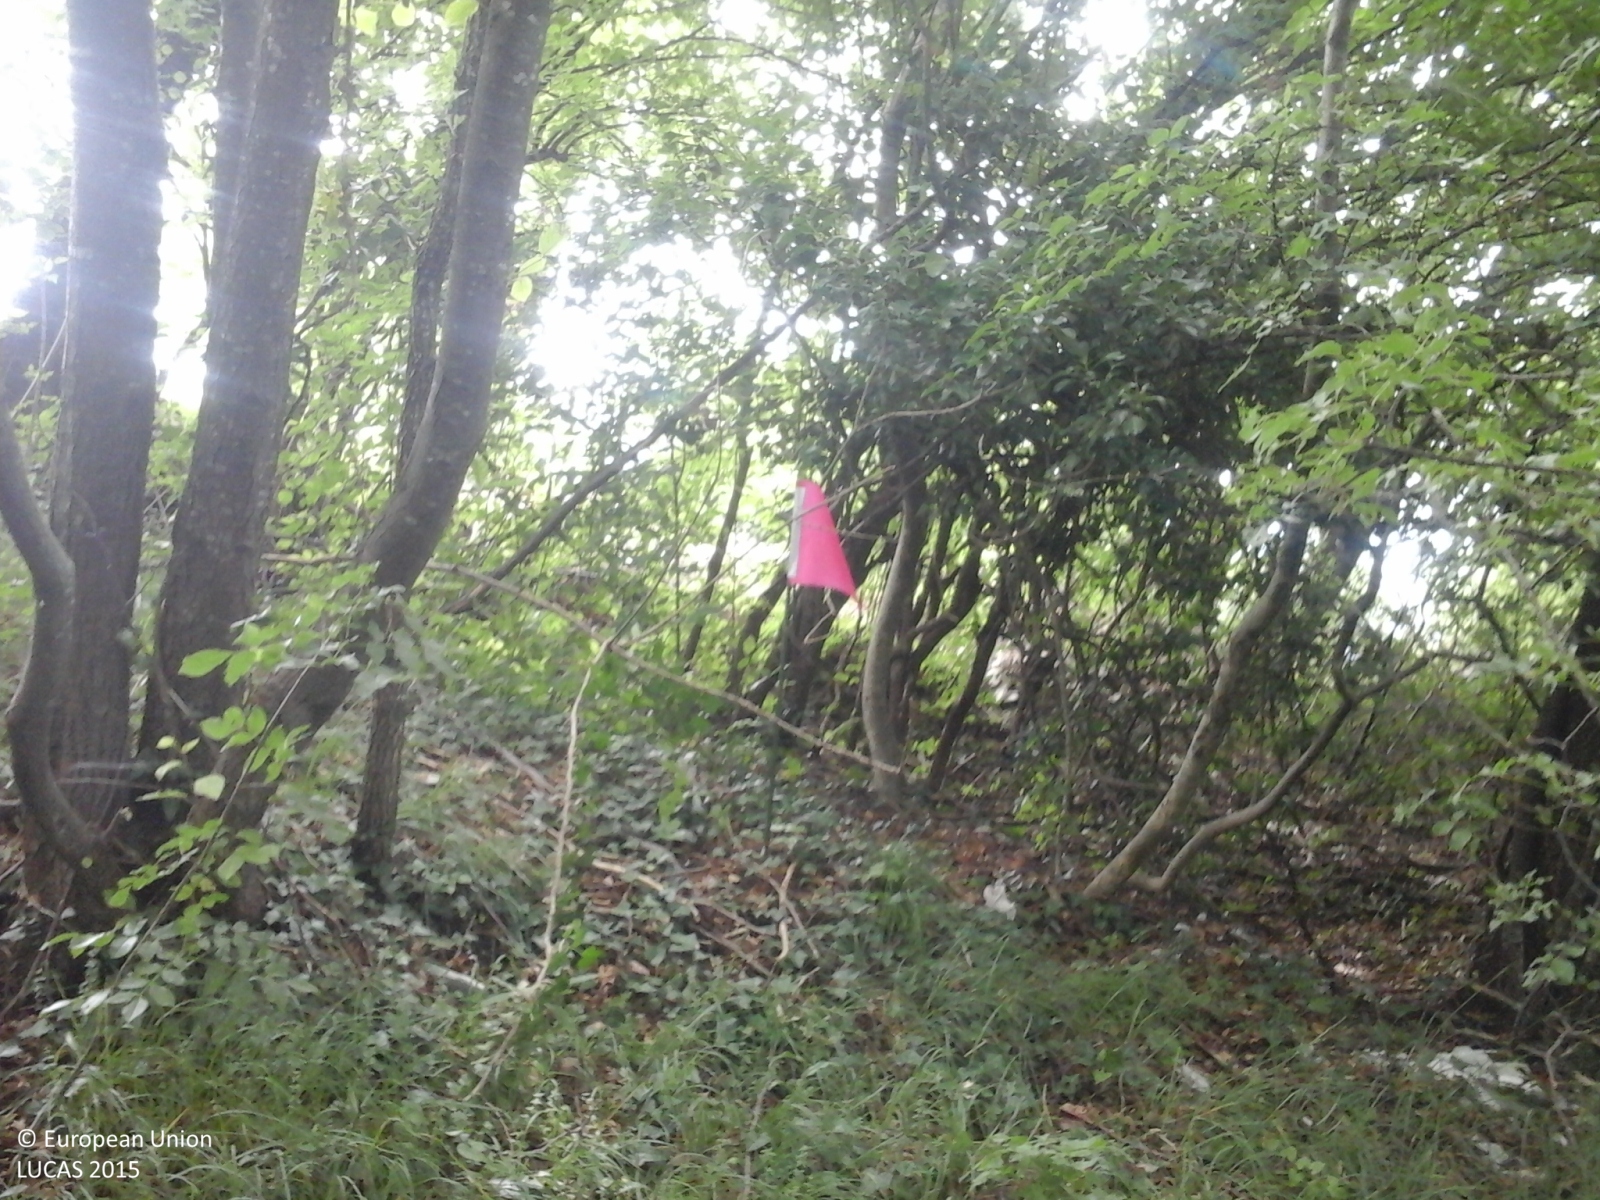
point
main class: Woodland
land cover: Broadleaved woodland
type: thermophilous deciduous forest
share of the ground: > 75 %
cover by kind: broadleaved forest trees 100 %
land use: Forestry
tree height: > 5 m
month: June
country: IT
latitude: 45.7817
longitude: 11.5283
